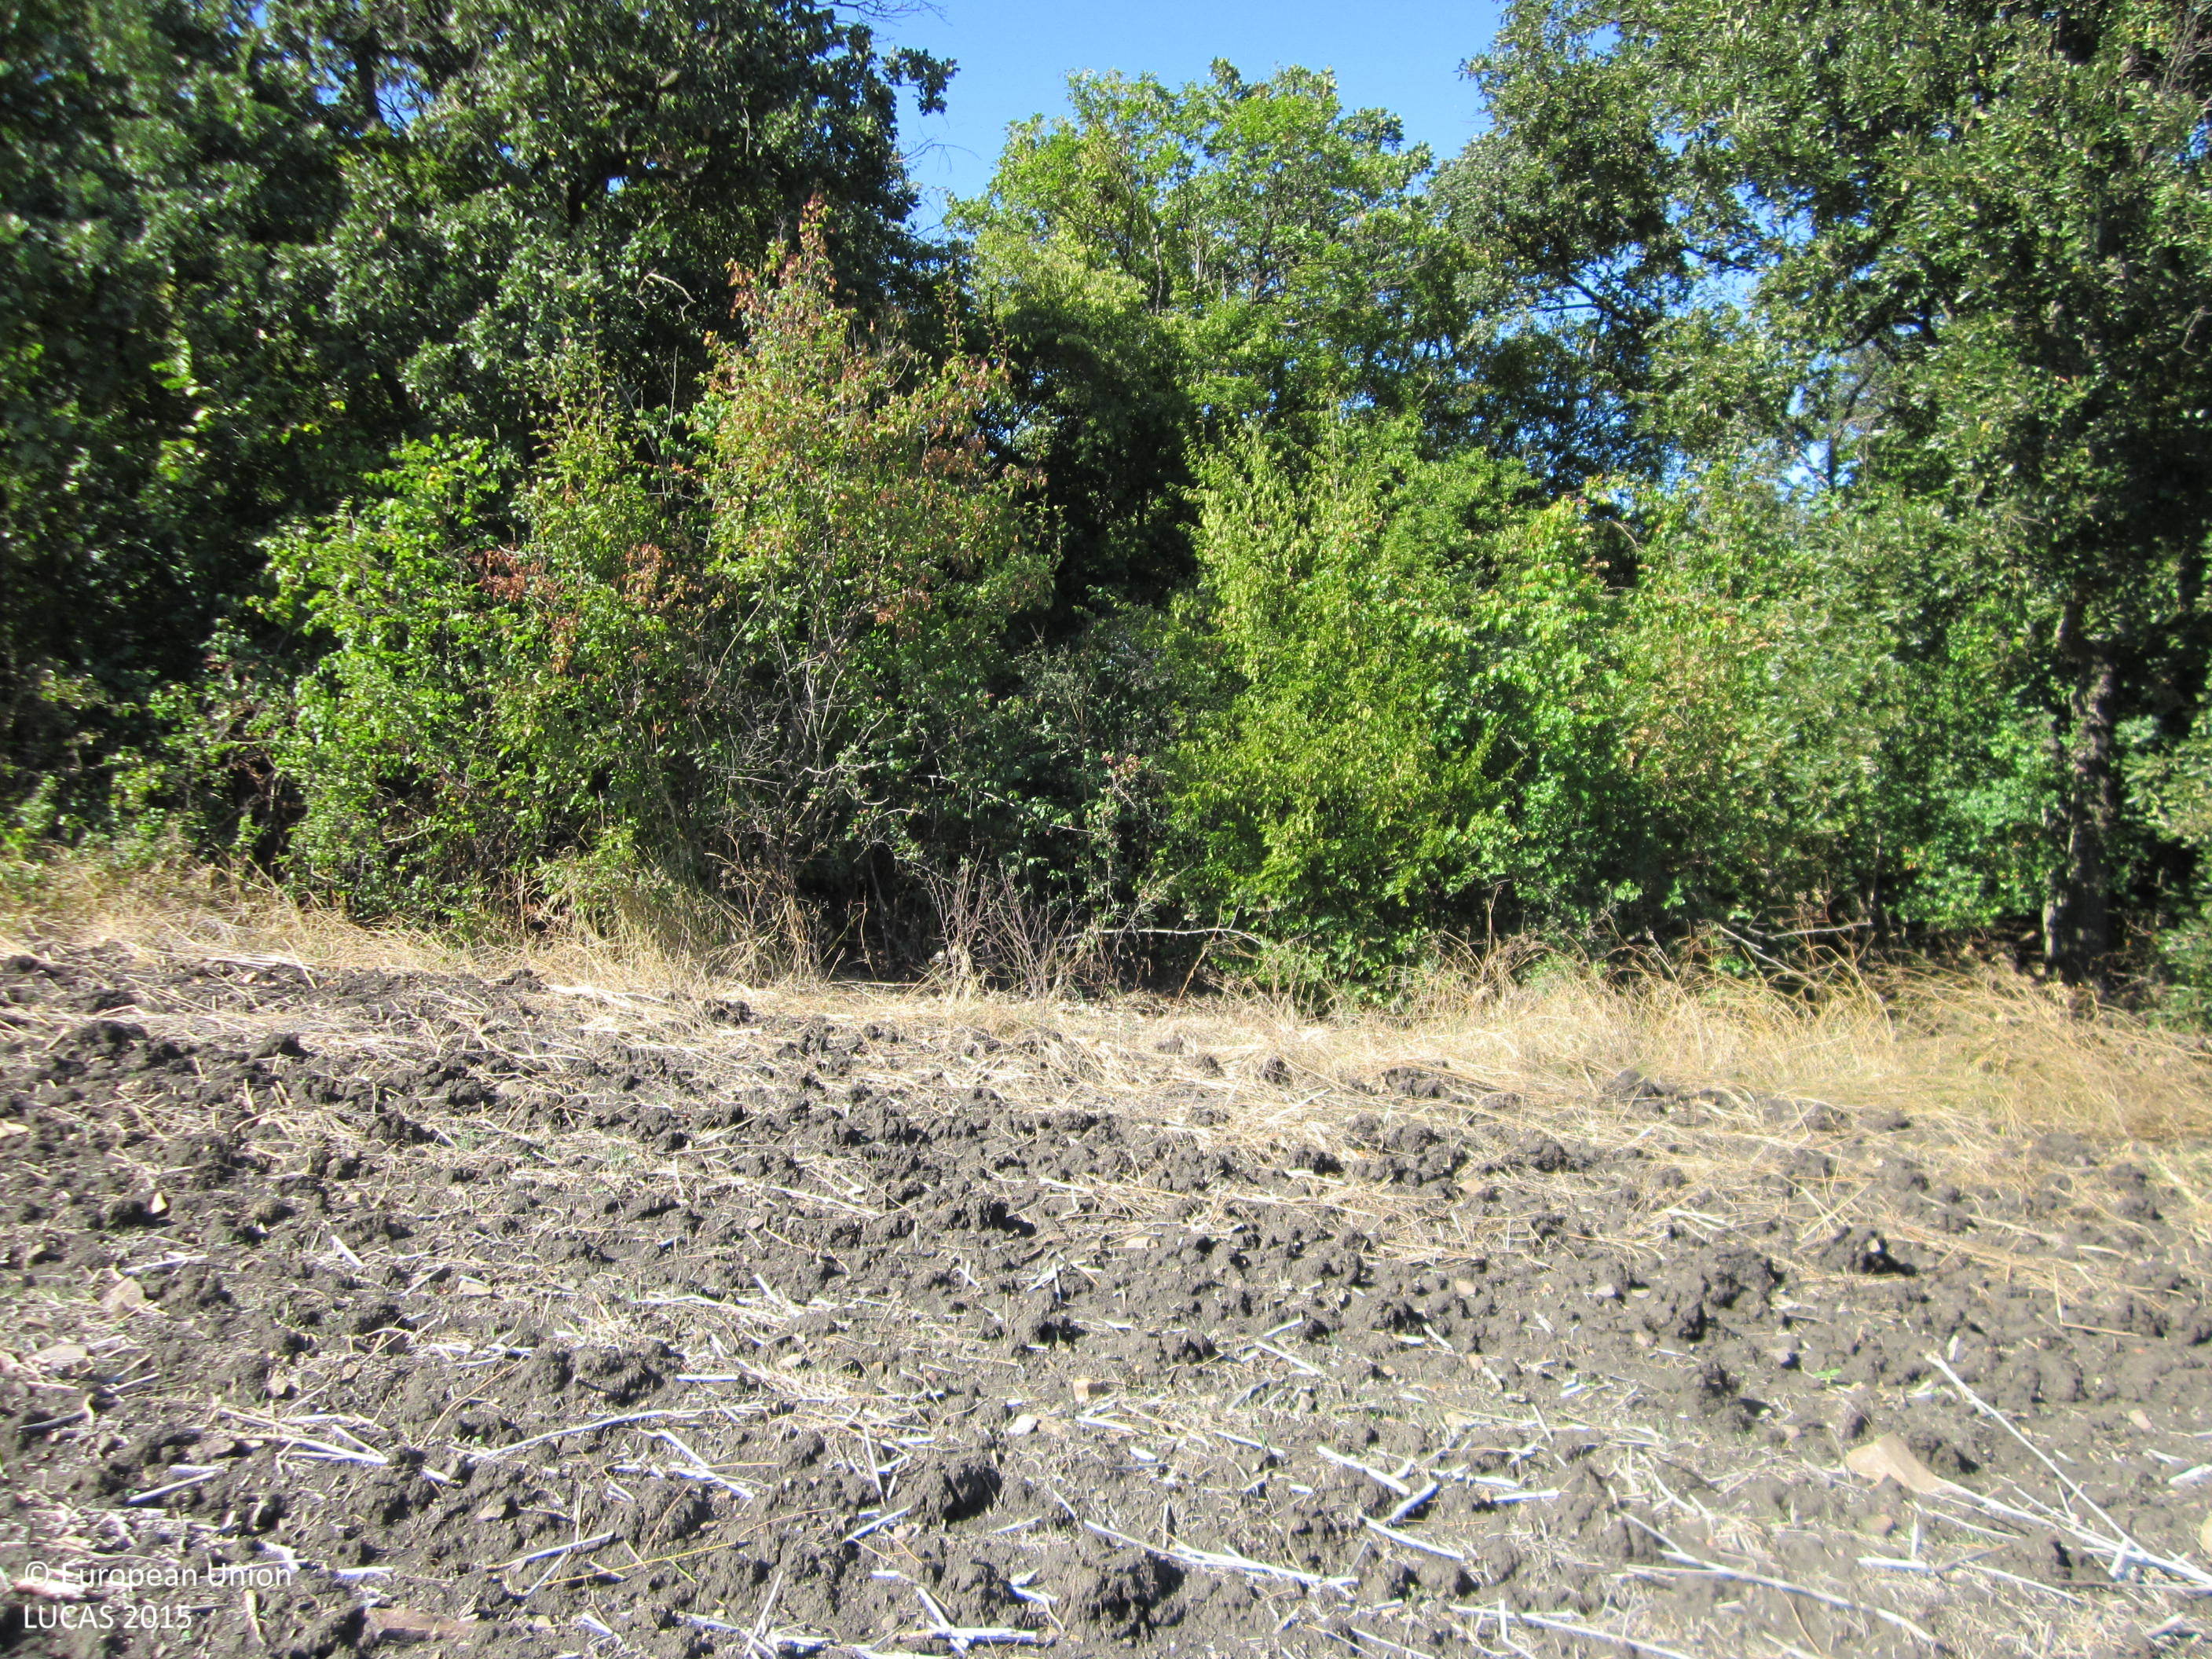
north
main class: Cropland
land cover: Sunflower
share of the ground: < 10 %
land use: Agriculture (excluding fallow land and kitchen gardens)
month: September
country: BG
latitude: 42.5020
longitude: 27.0574
